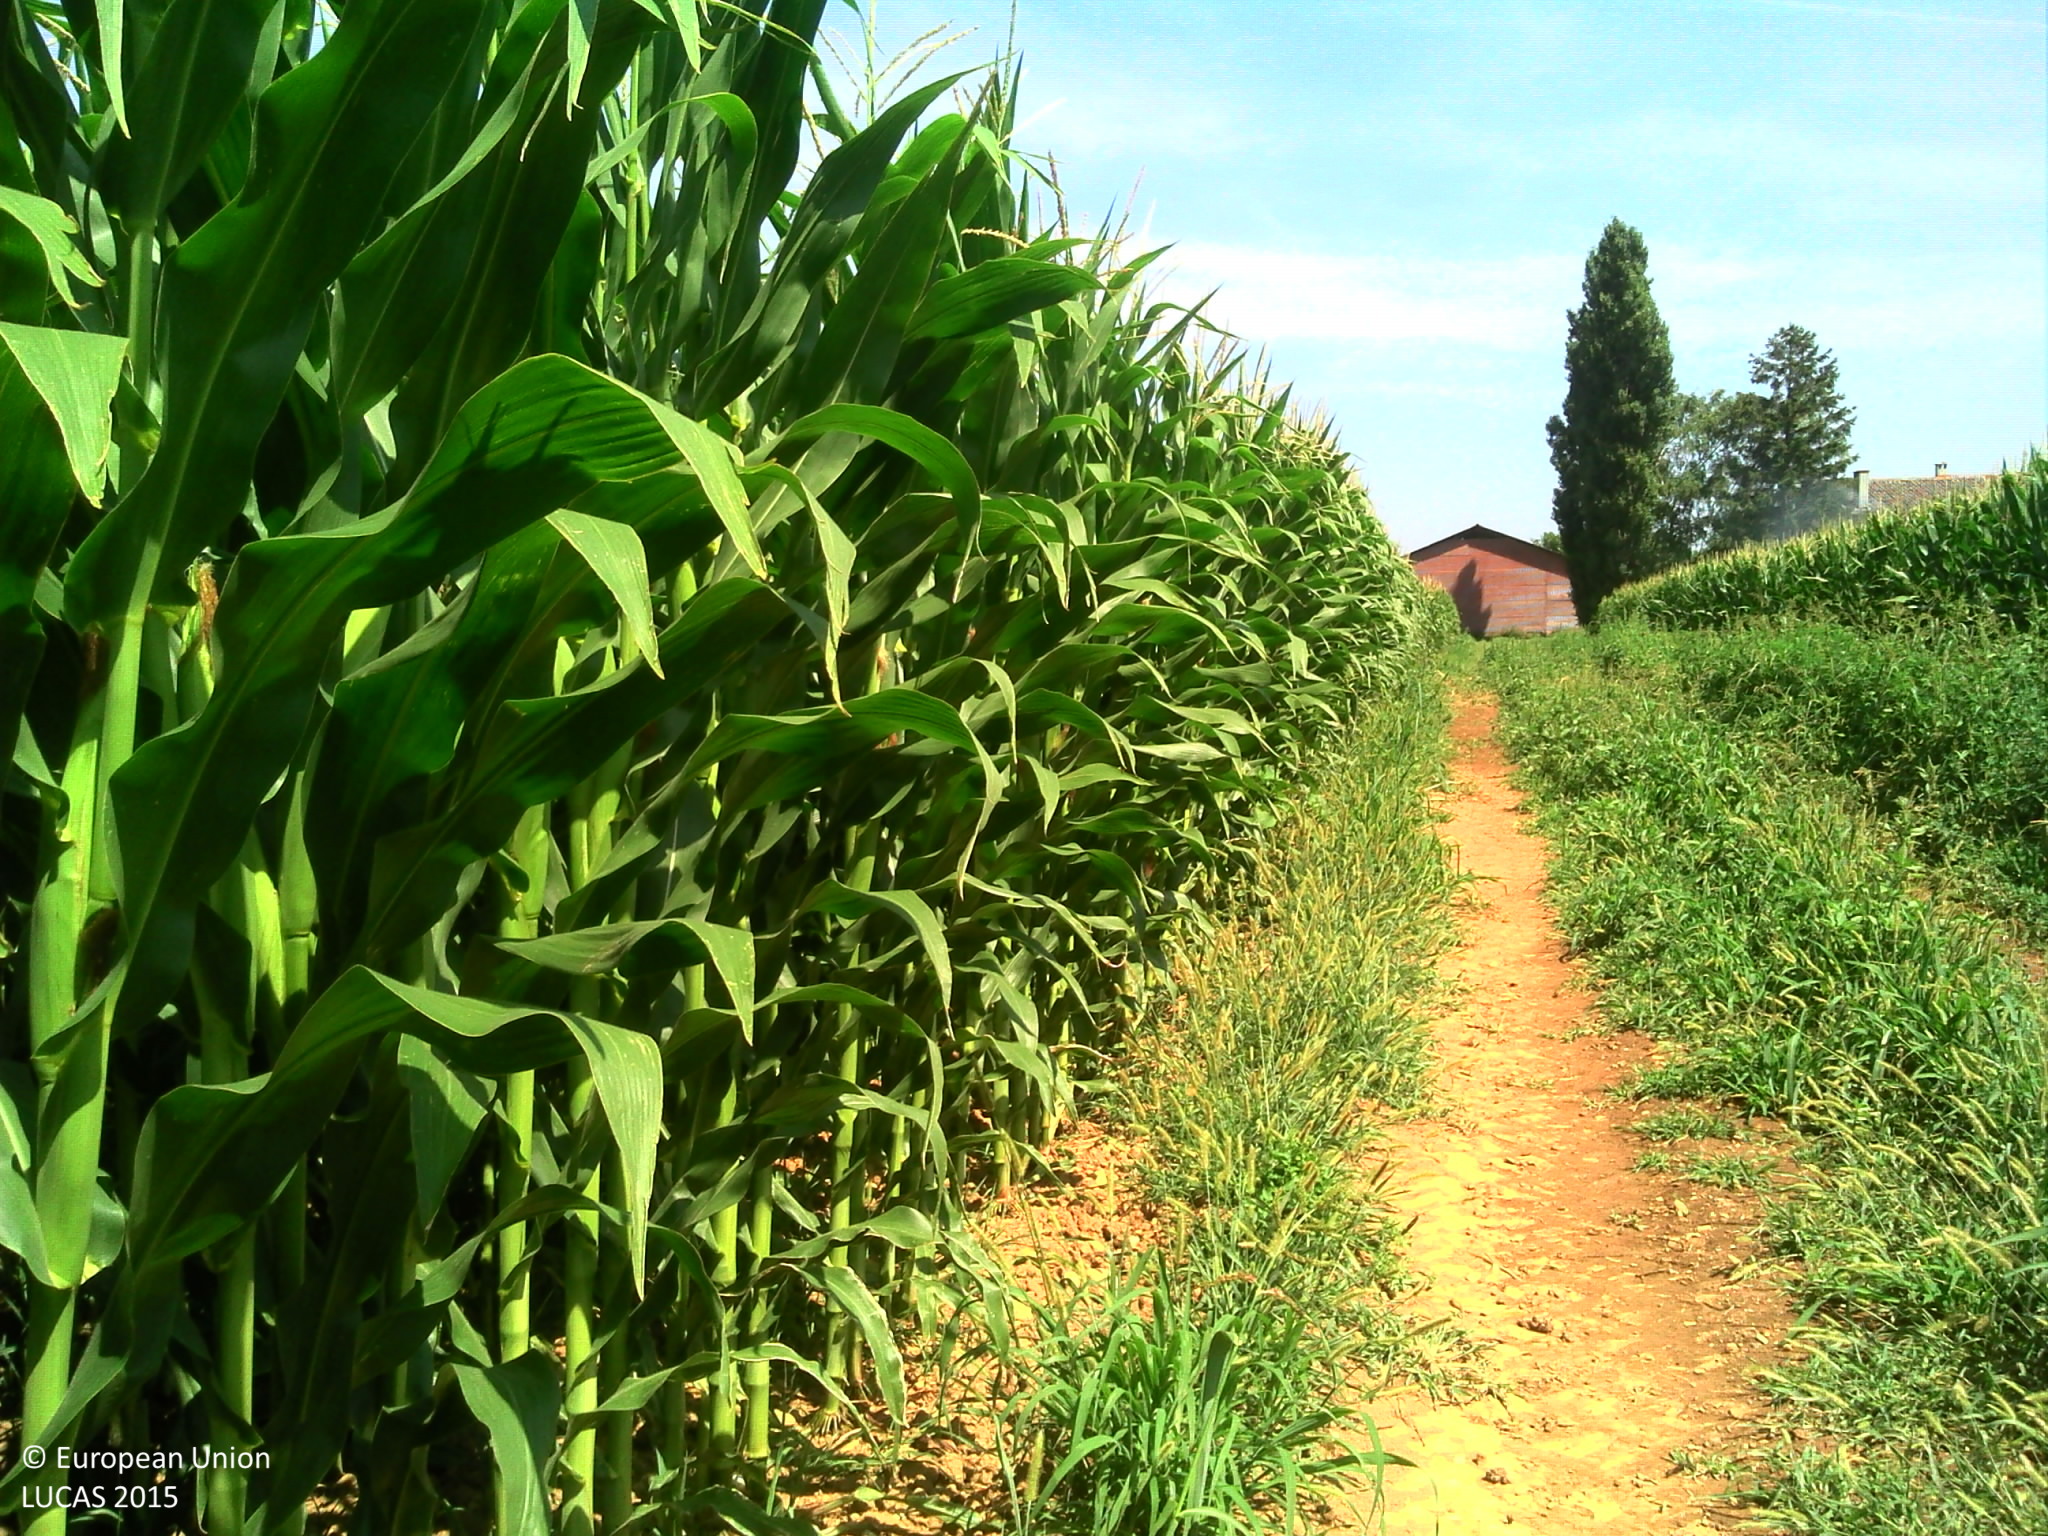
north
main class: Cropland
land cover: Maize
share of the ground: > 75 %
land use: Agriculture (excluding fallow land and kitchen gardens)
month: July
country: FR
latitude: 45.0089
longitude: 5.0447
